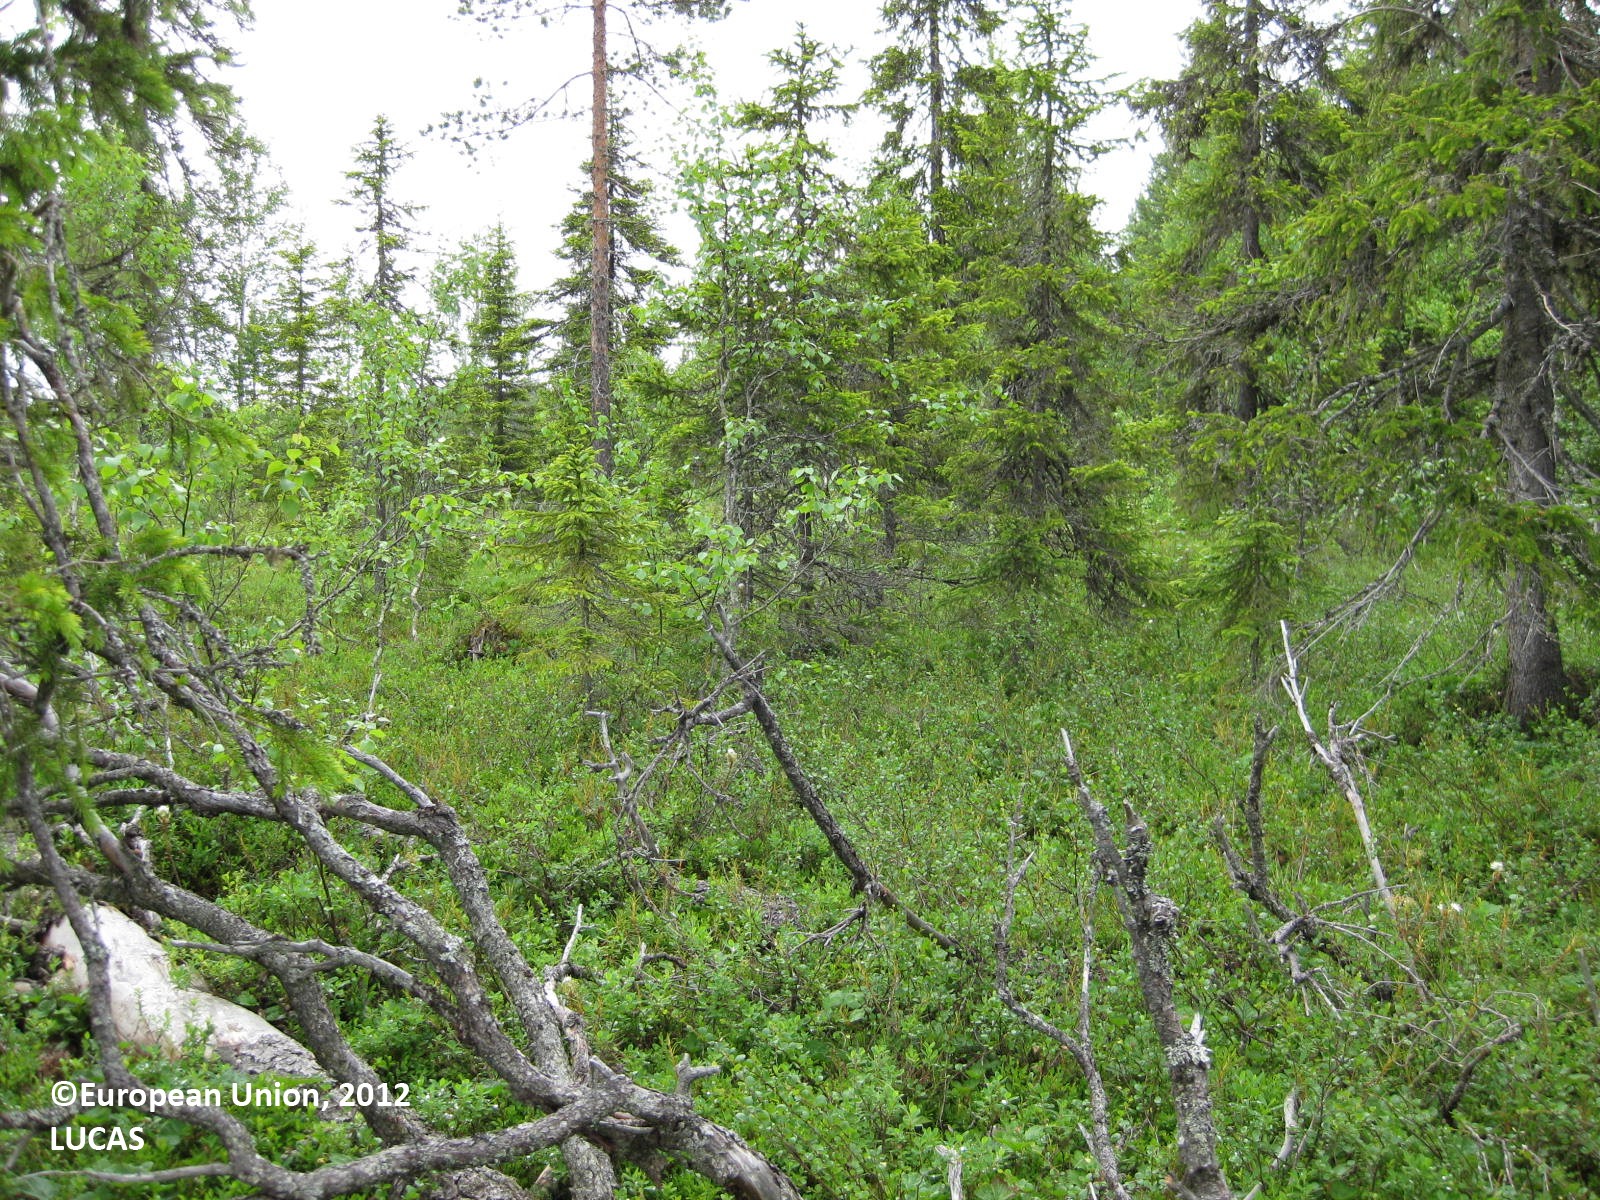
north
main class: Woodland
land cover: Spruce dominated coniferous woodland
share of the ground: 25 - 50 %
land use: Forestry
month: July
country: FI
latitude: 65.4562
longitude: 28.3894
